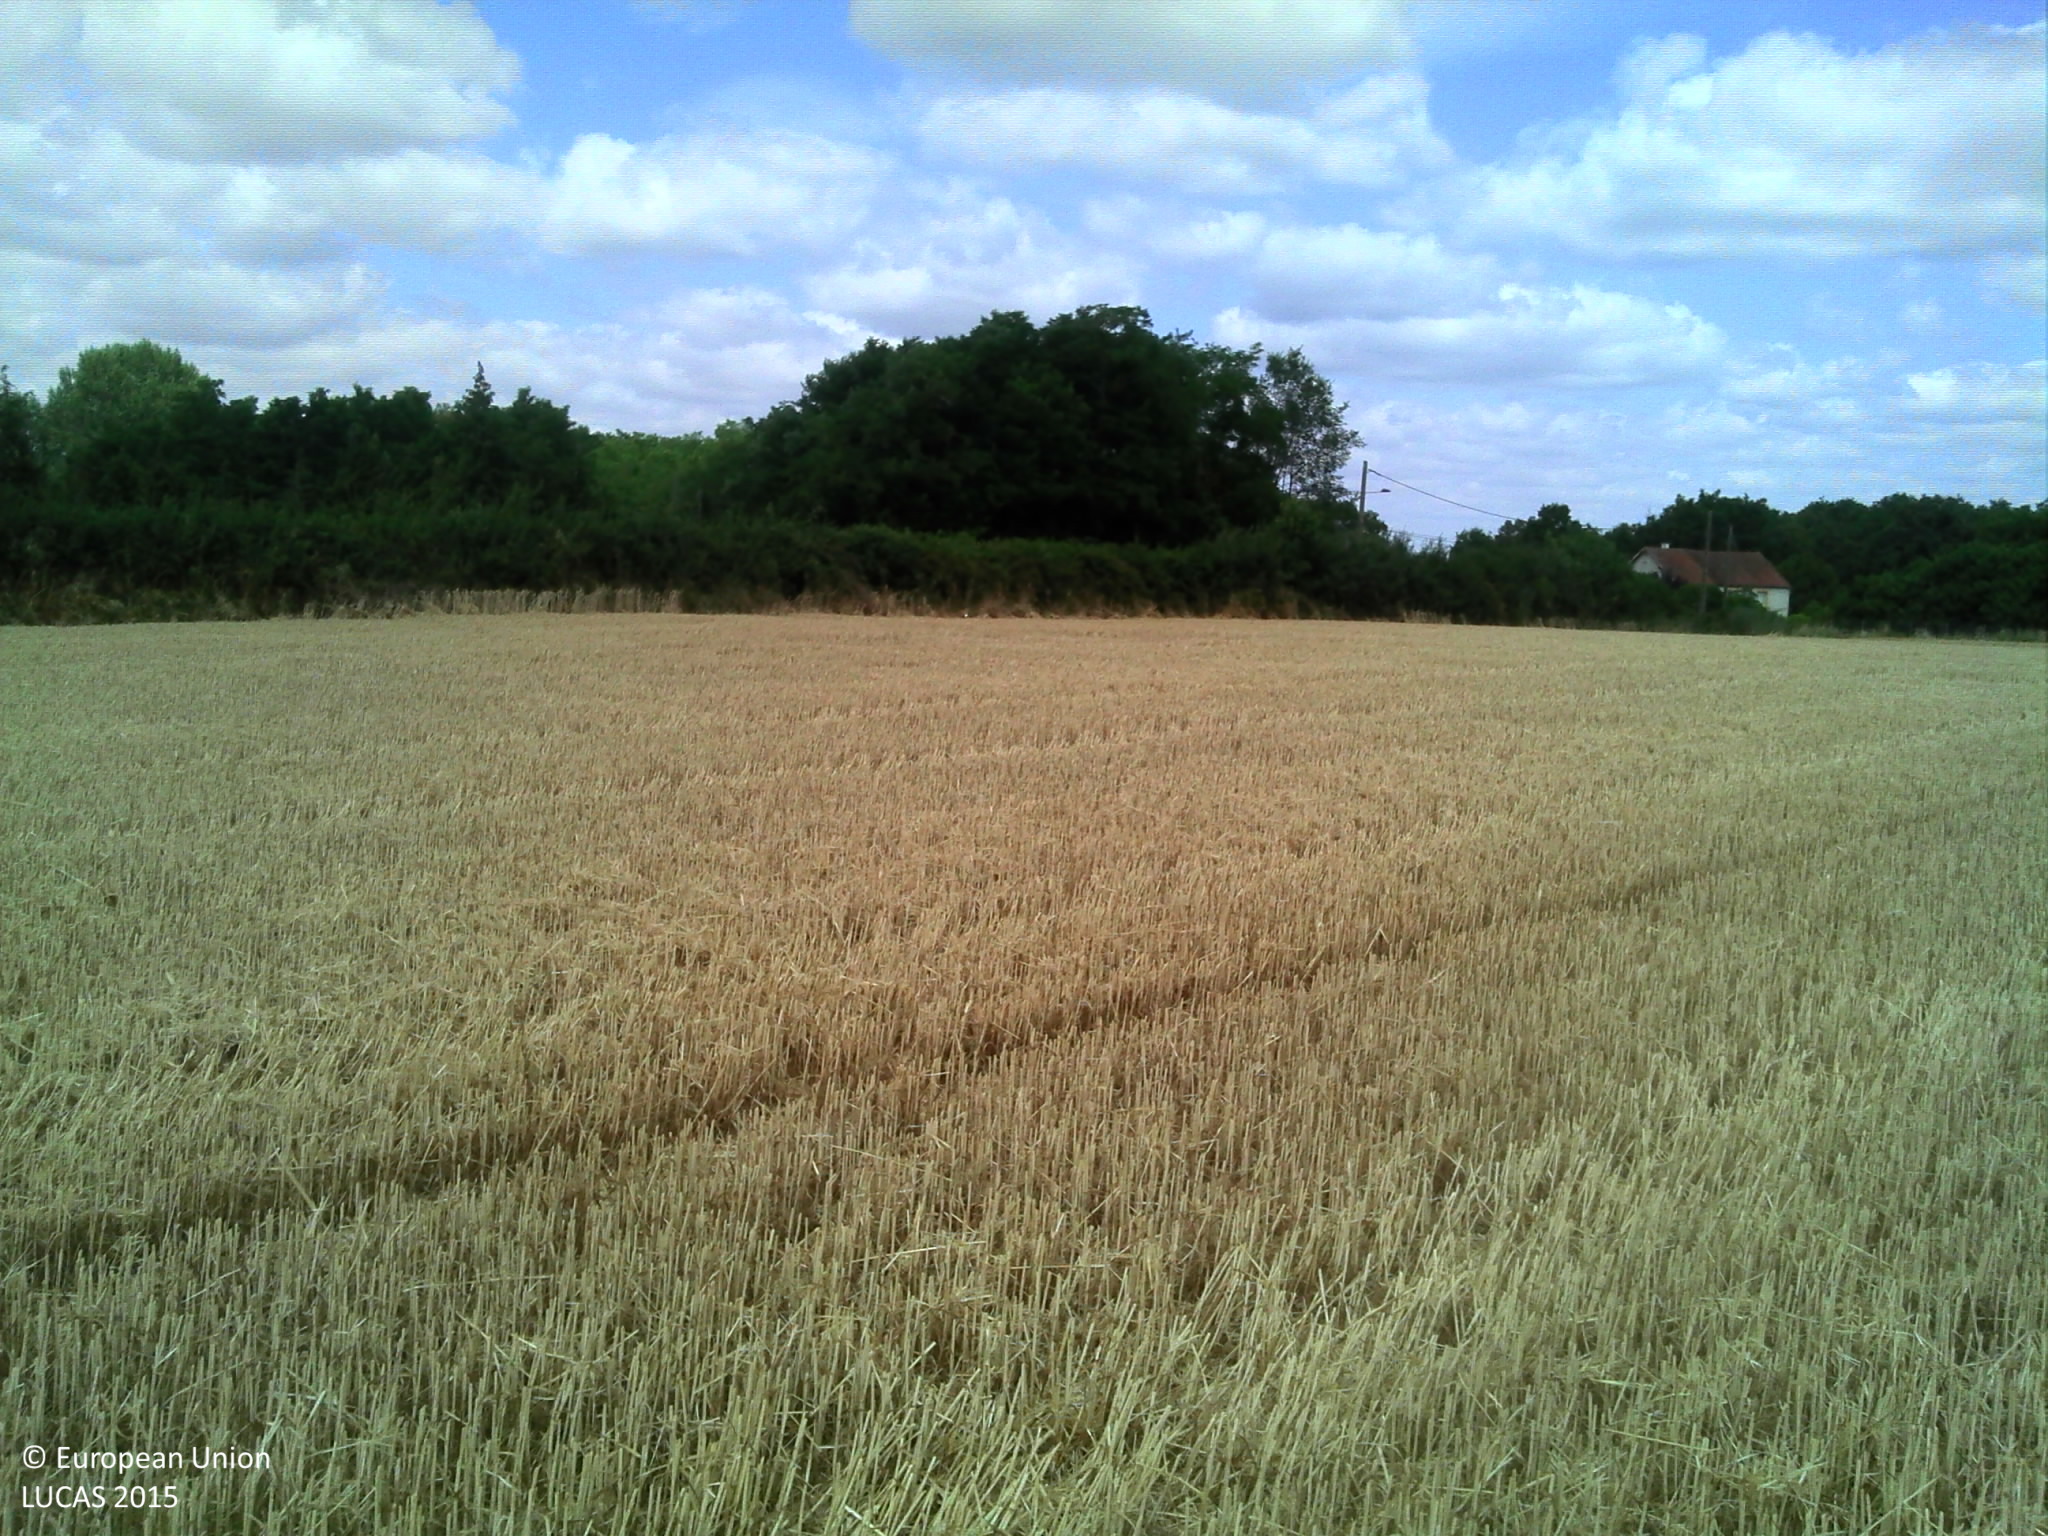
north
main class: Cropland
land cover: Common wheat
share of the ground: > 75 %
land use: Agriculture (excluding fallow land and kitchen gardens)
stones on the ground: 10 - 25 %
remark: Harvested field
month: July
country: FR
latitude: 47.7218
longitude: 3.4498
